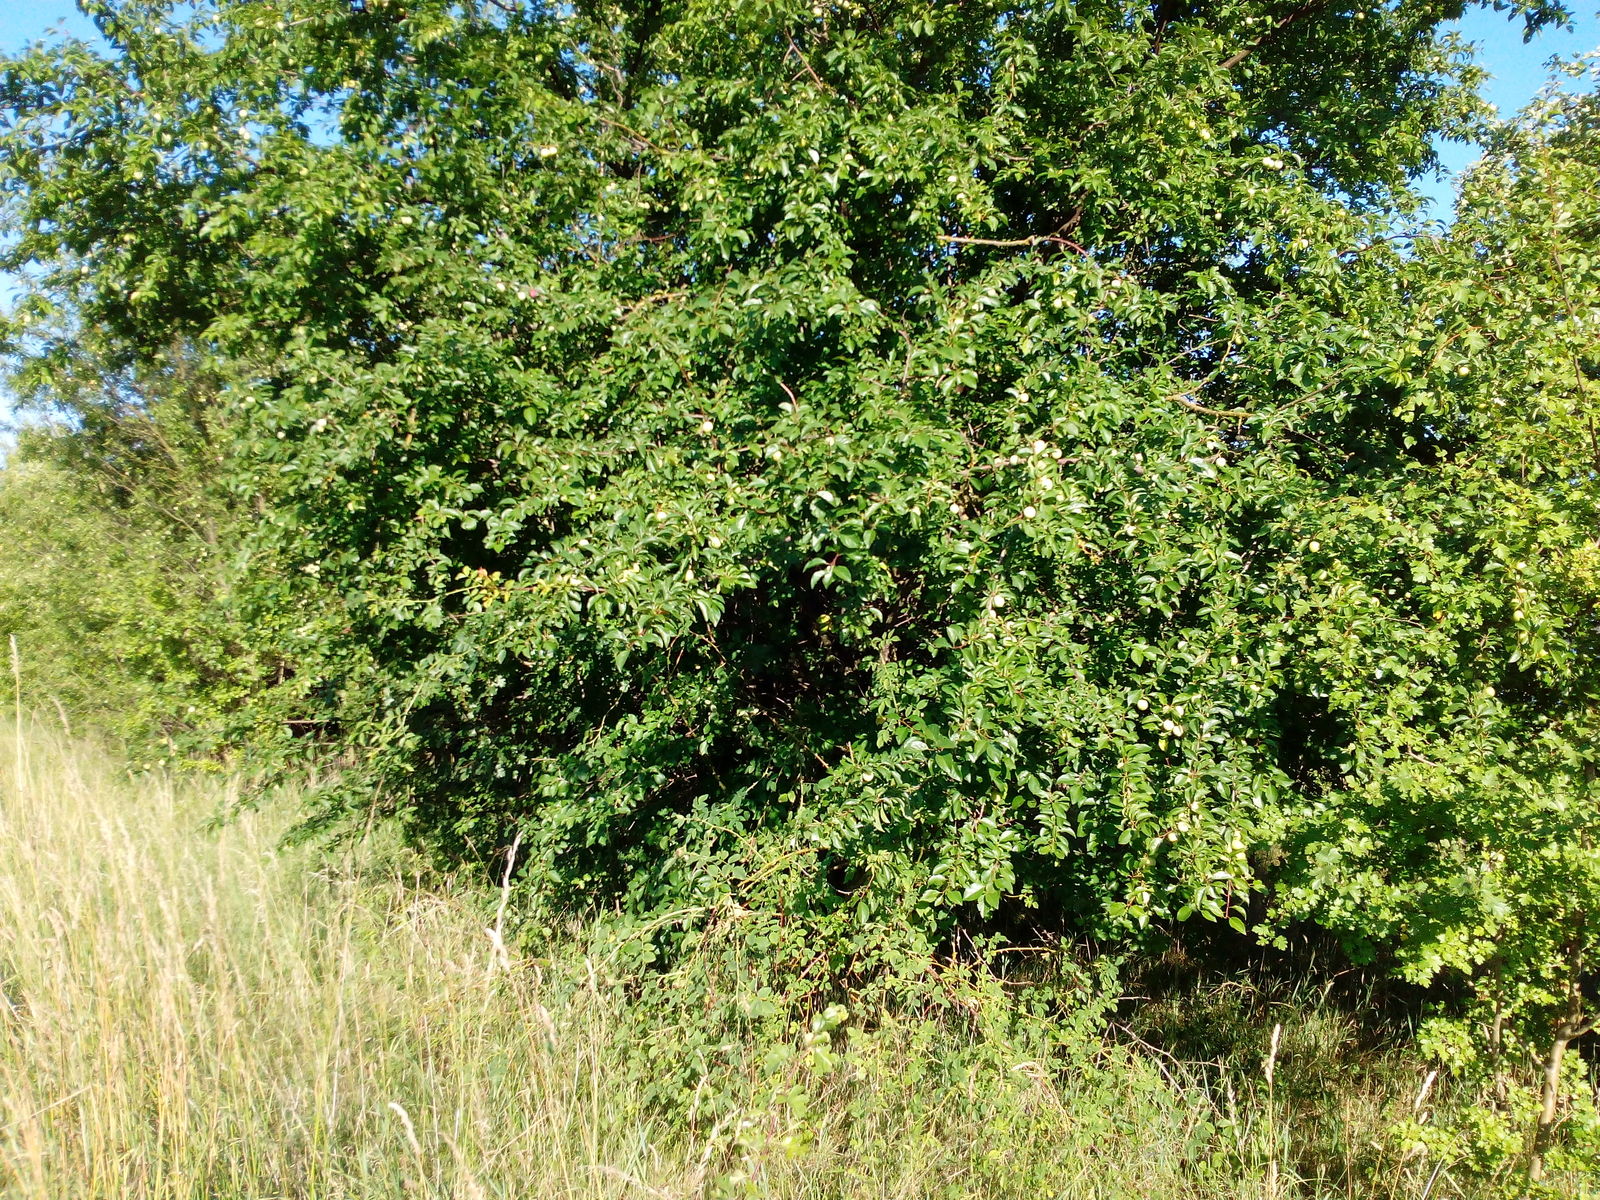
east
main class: Woodland
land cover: Broadleaved woodland
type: mesophytic deciduous forest
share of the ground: 50 - 75 %
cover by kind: broadleaved forest trees 70 %, shrubs 30 %
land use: Abandoned areas
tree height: > 5 m
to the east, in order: Tracks; Grass margins; Broadleaved woodland; Inland marshes; Inland fresh water bodies
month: July
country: DE
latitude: 51.1512
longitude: 10.9576
